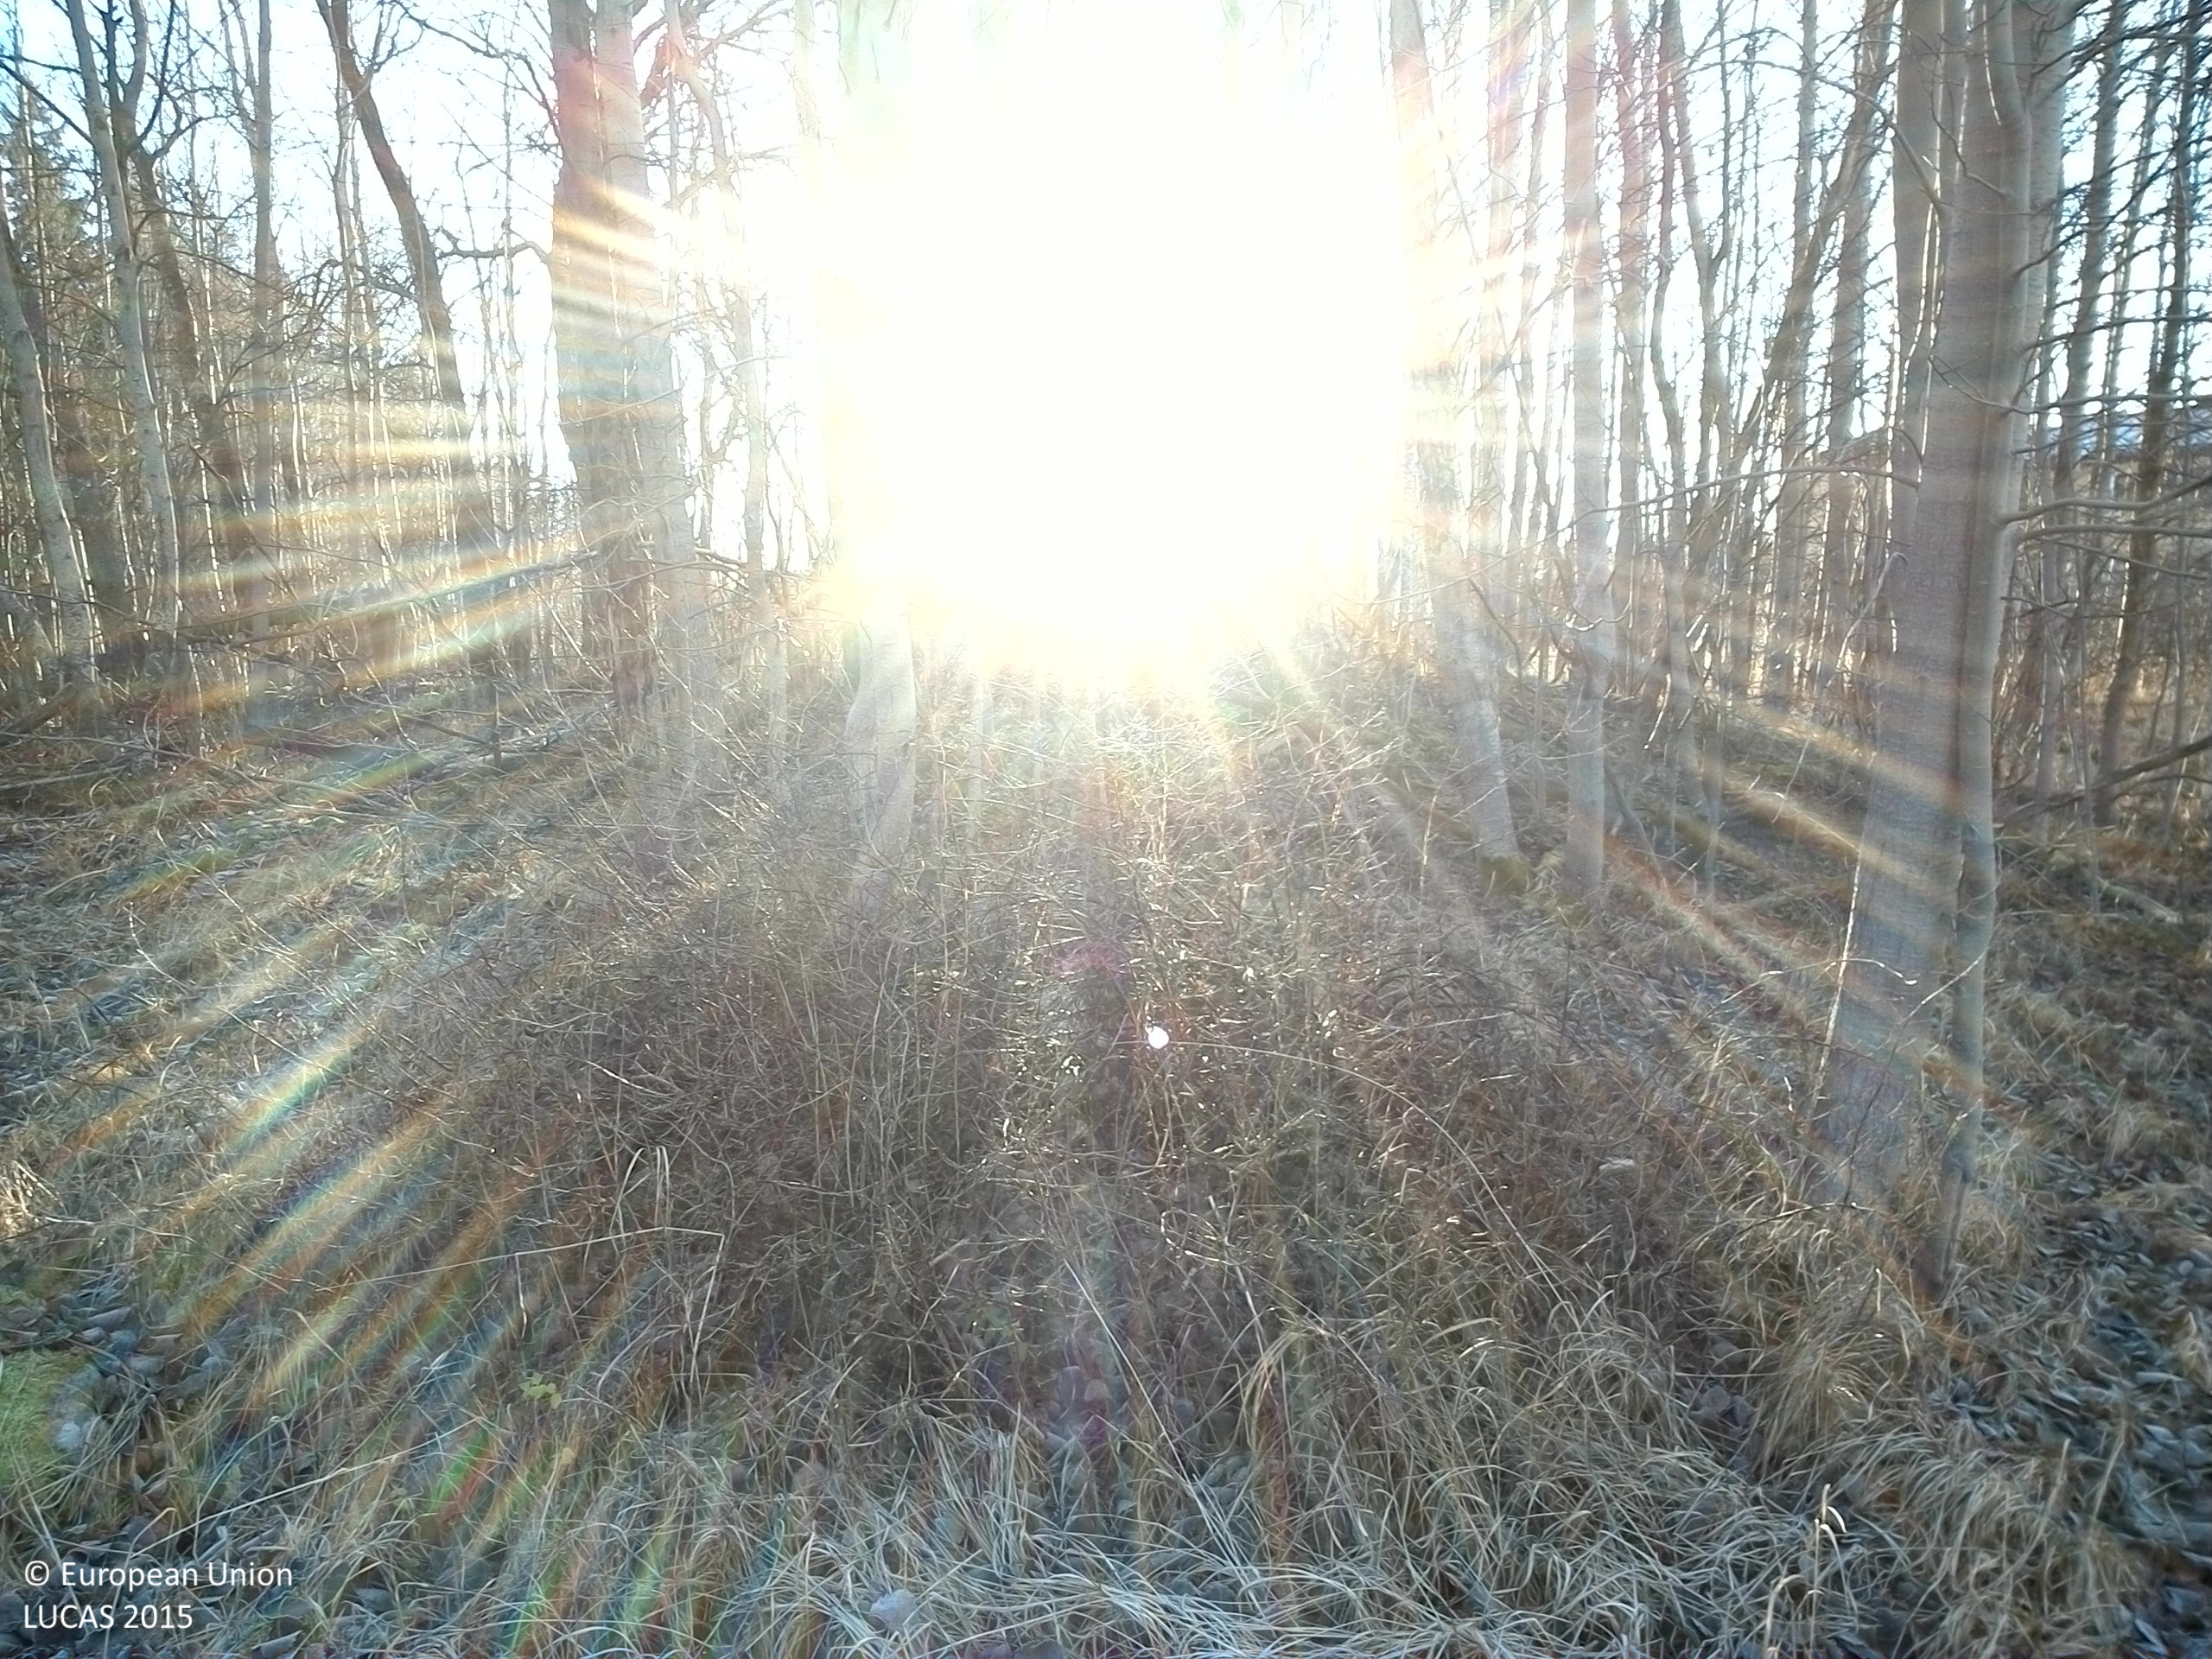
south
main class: Grassland
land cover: Grassland with sparse tree/shrub cover
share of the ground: > 75 %
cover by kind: herbaceous plants 90 %, broadleaved forest trees 5 %, shrubs 5 %
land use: Fallow land
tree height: > 5 m
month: December
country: SE
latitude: 59.4168
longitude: 16.4949
